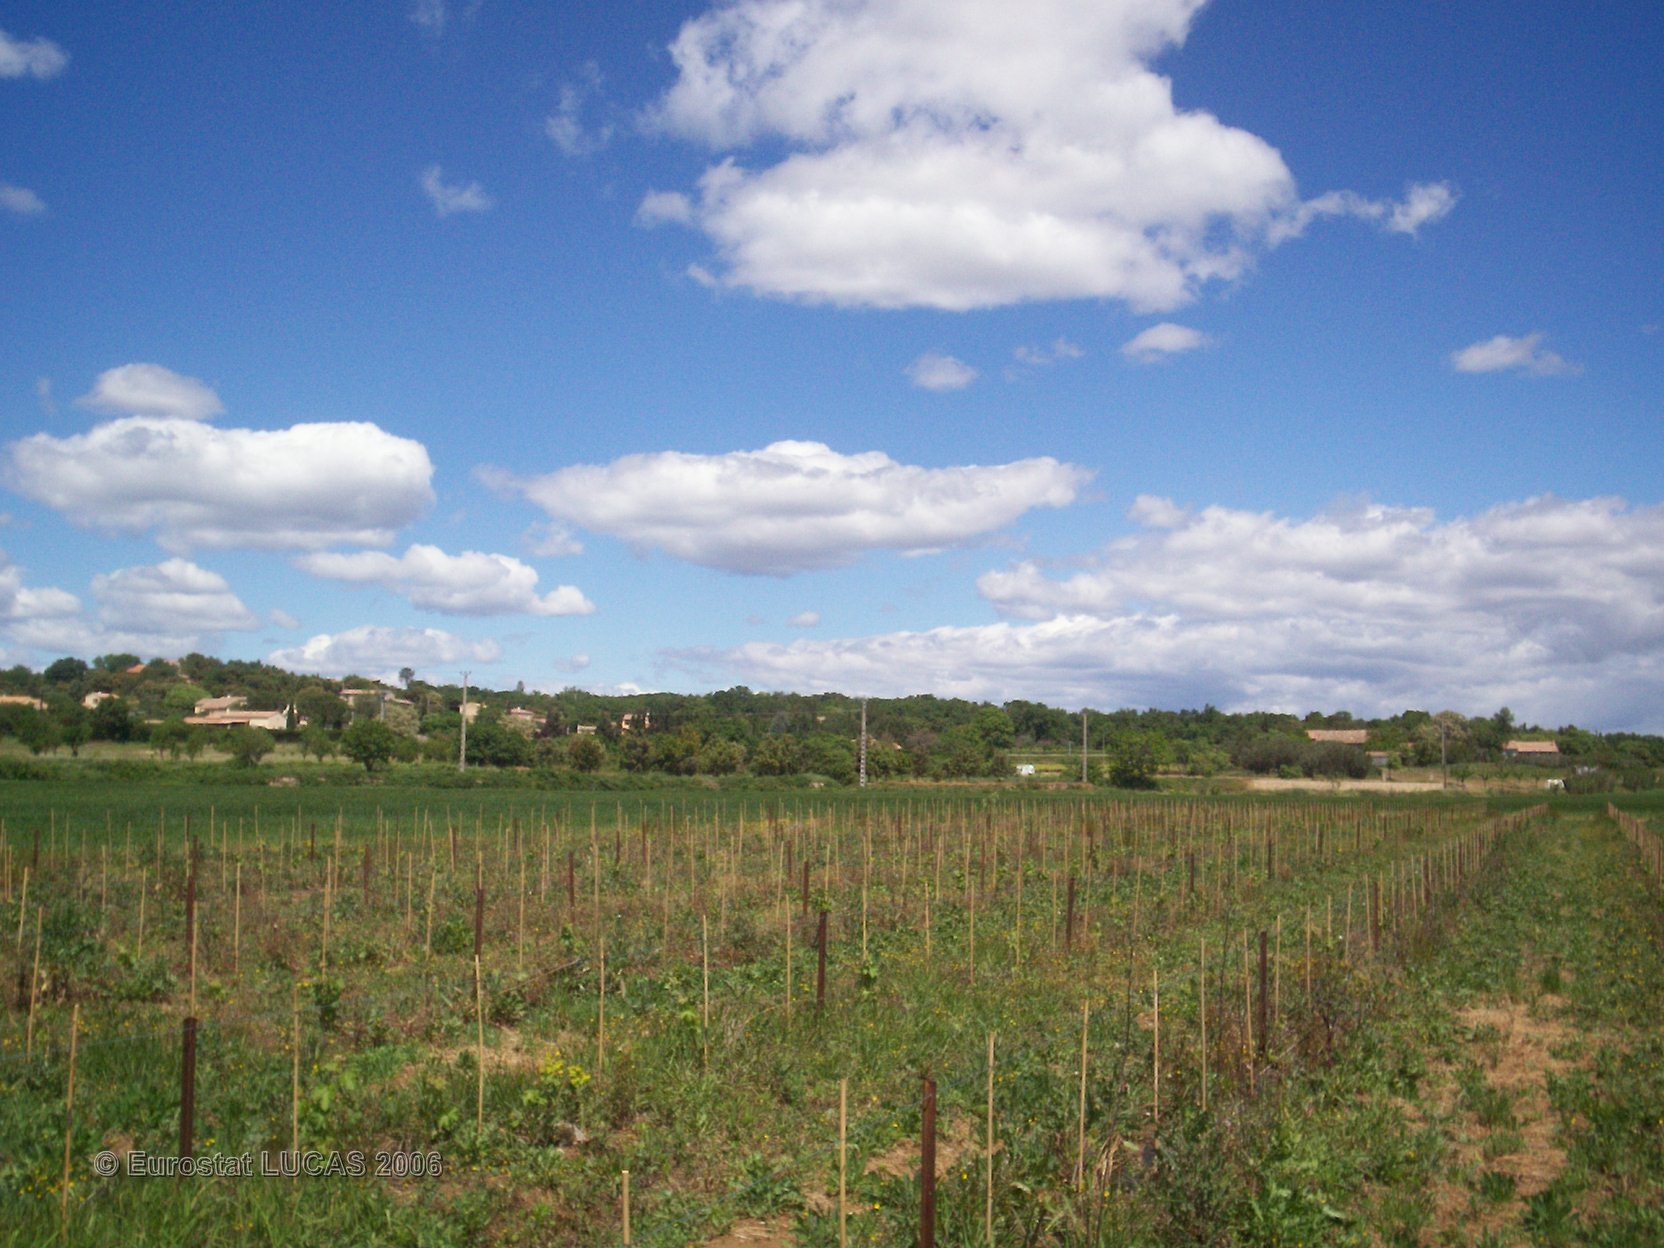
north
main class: Cropland
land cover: Vineyards
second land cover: Grassland with sparse tree/shrub cover
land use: Agriculture (excluding fallow land and kitchen gardens)
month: May
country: FR
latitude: 44.0396
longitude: 4.4549
